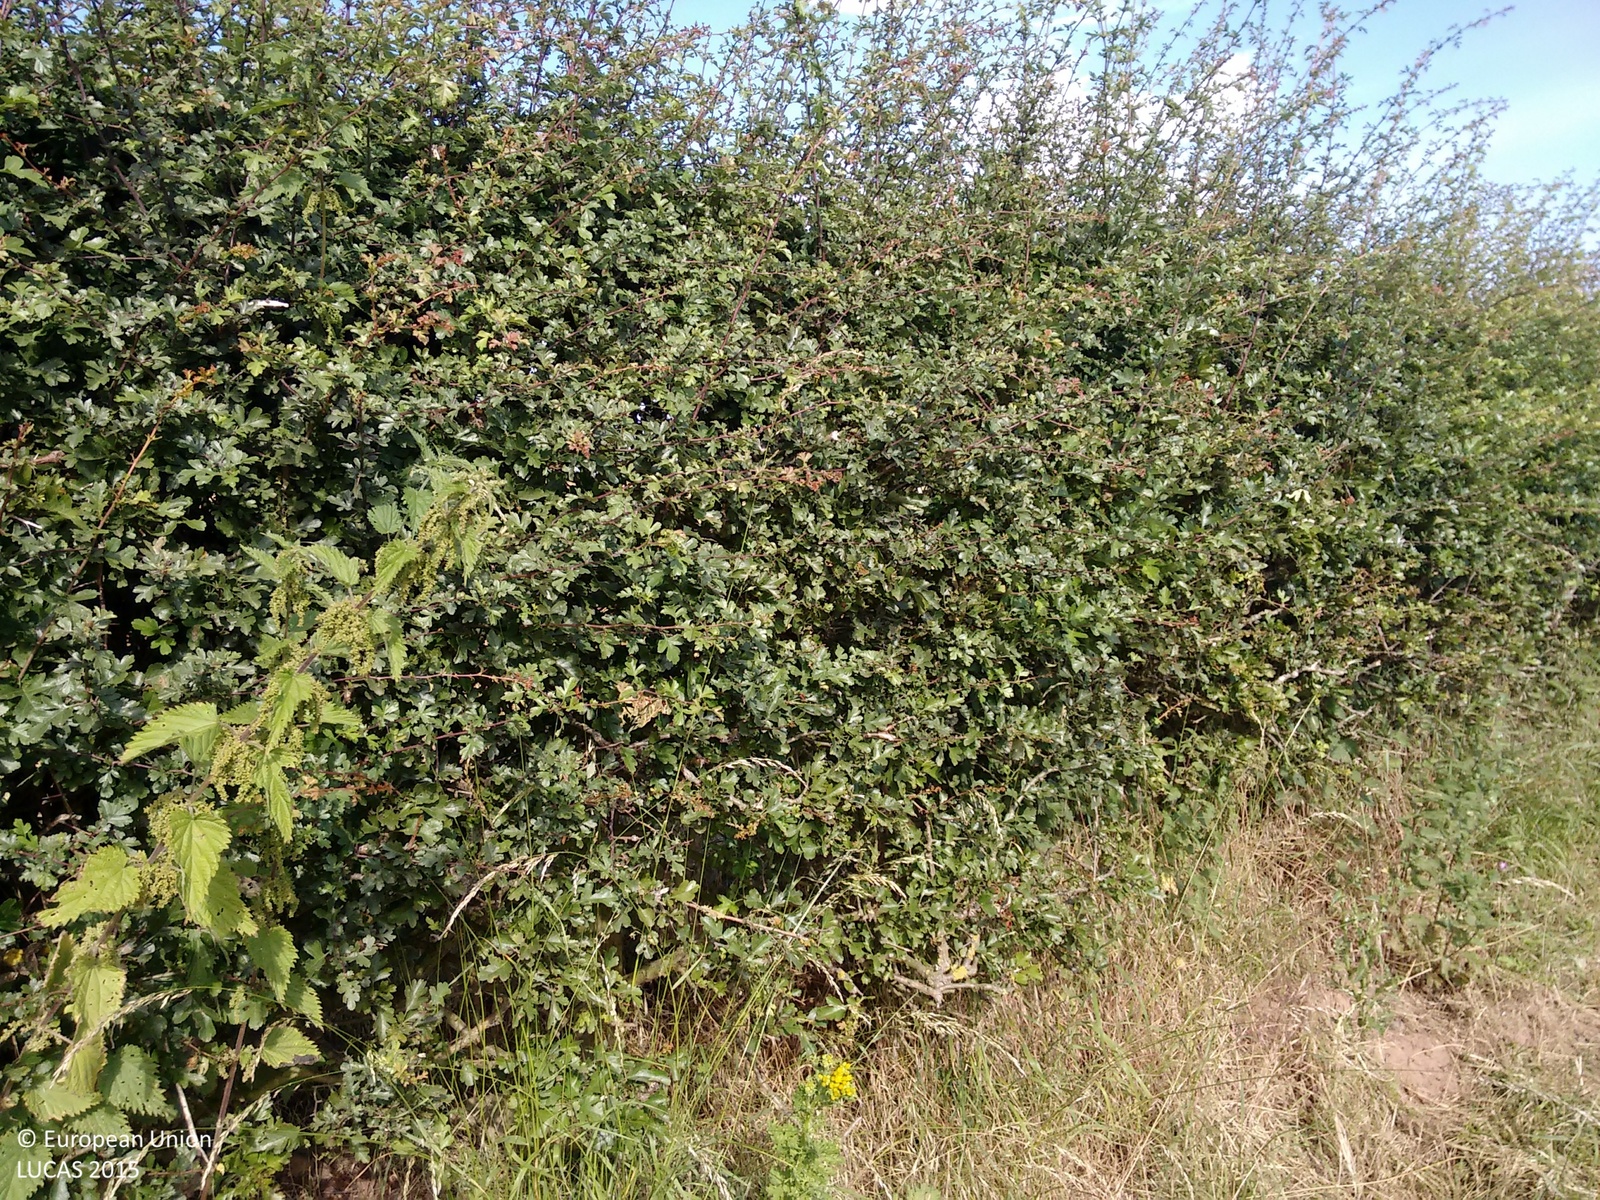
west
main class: Cropland
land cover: Barley
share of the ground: > 75 %
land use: Agriculture (excluding fallow land and kitchen gardens)
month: July
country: GB
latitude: 53.2824
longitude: -0.9774
